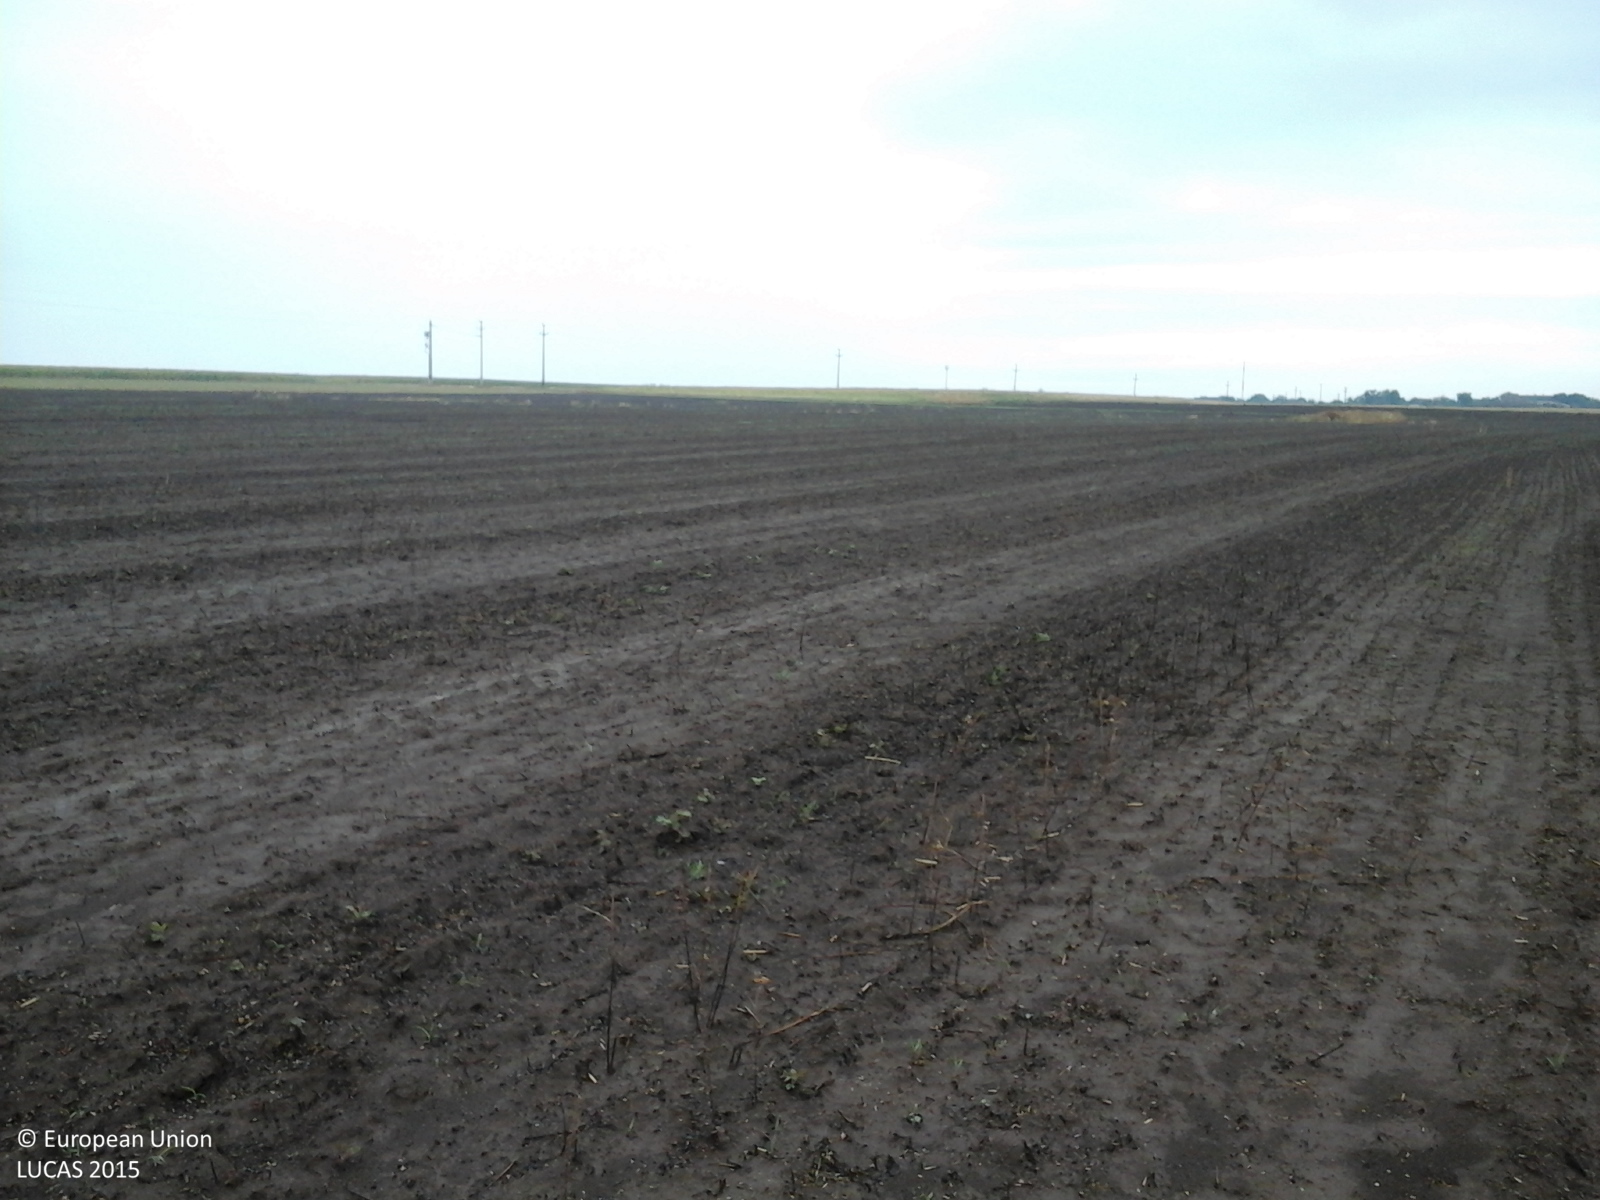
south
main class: Cropland
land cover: Common wheat
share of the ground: < 10 %
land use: Agriculture (excluding fallow land and kitchen gardens)
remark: Burnt area
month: August
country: RO
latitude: 45.9905
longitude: 21.4340
